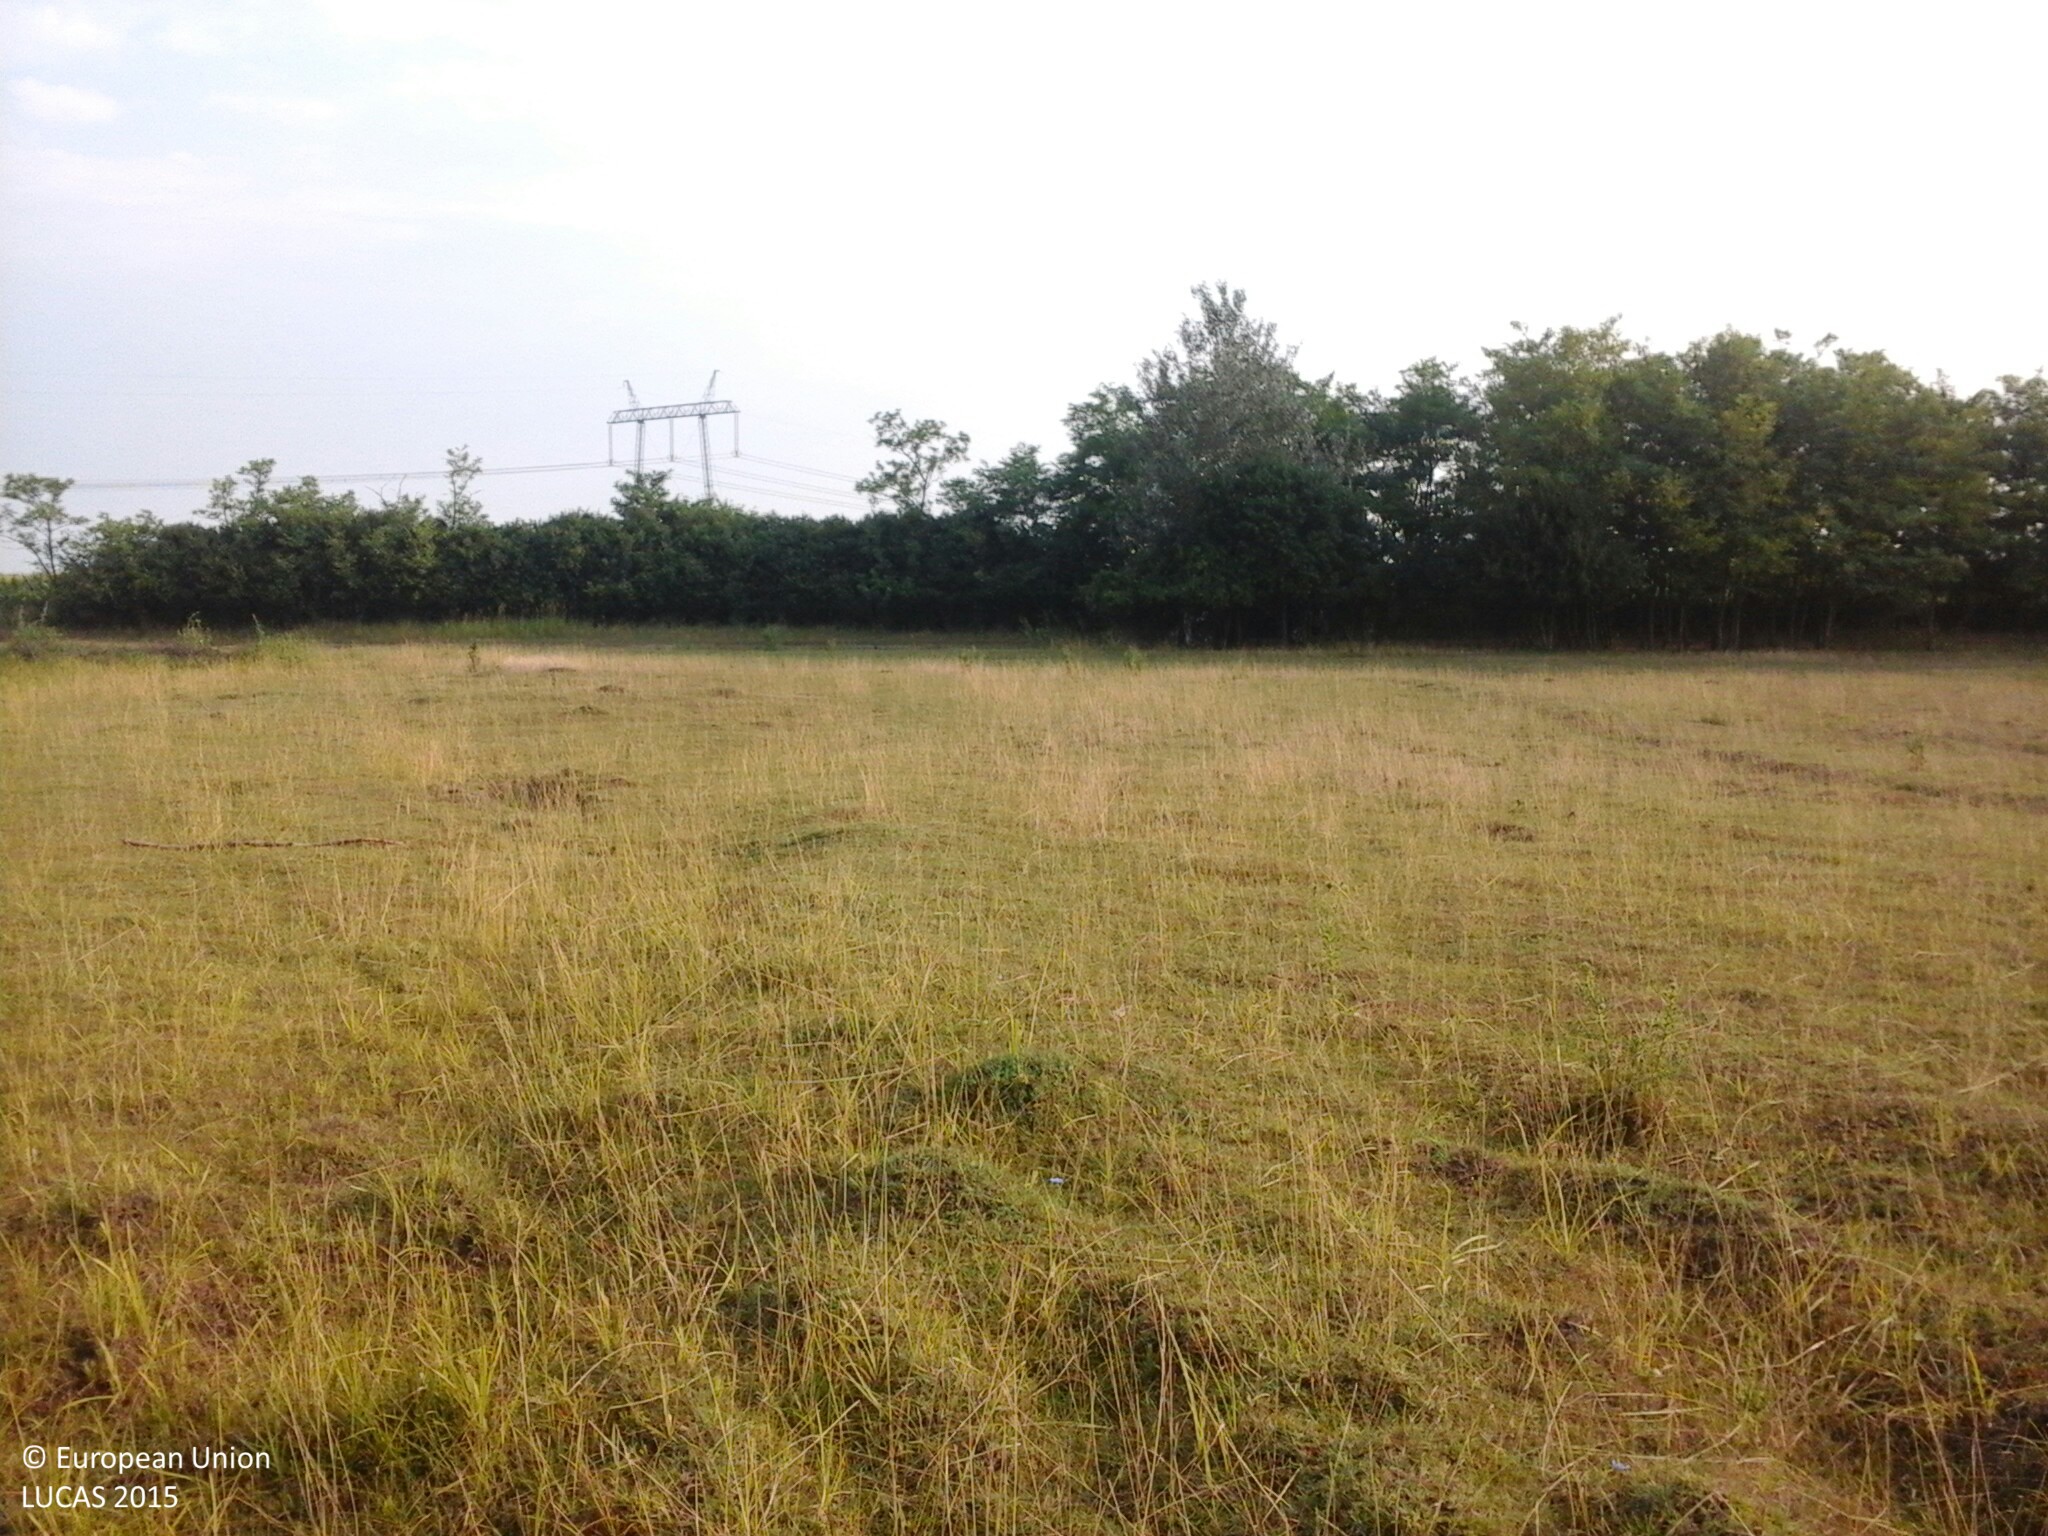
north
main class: Grassland
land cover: Grassland without tree/shrub cover
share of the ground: > 75 %
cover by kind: herbaceous plants 100 %
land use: Abandoned areas
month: June
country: HU
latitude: 47.7745
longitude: 21.7508
